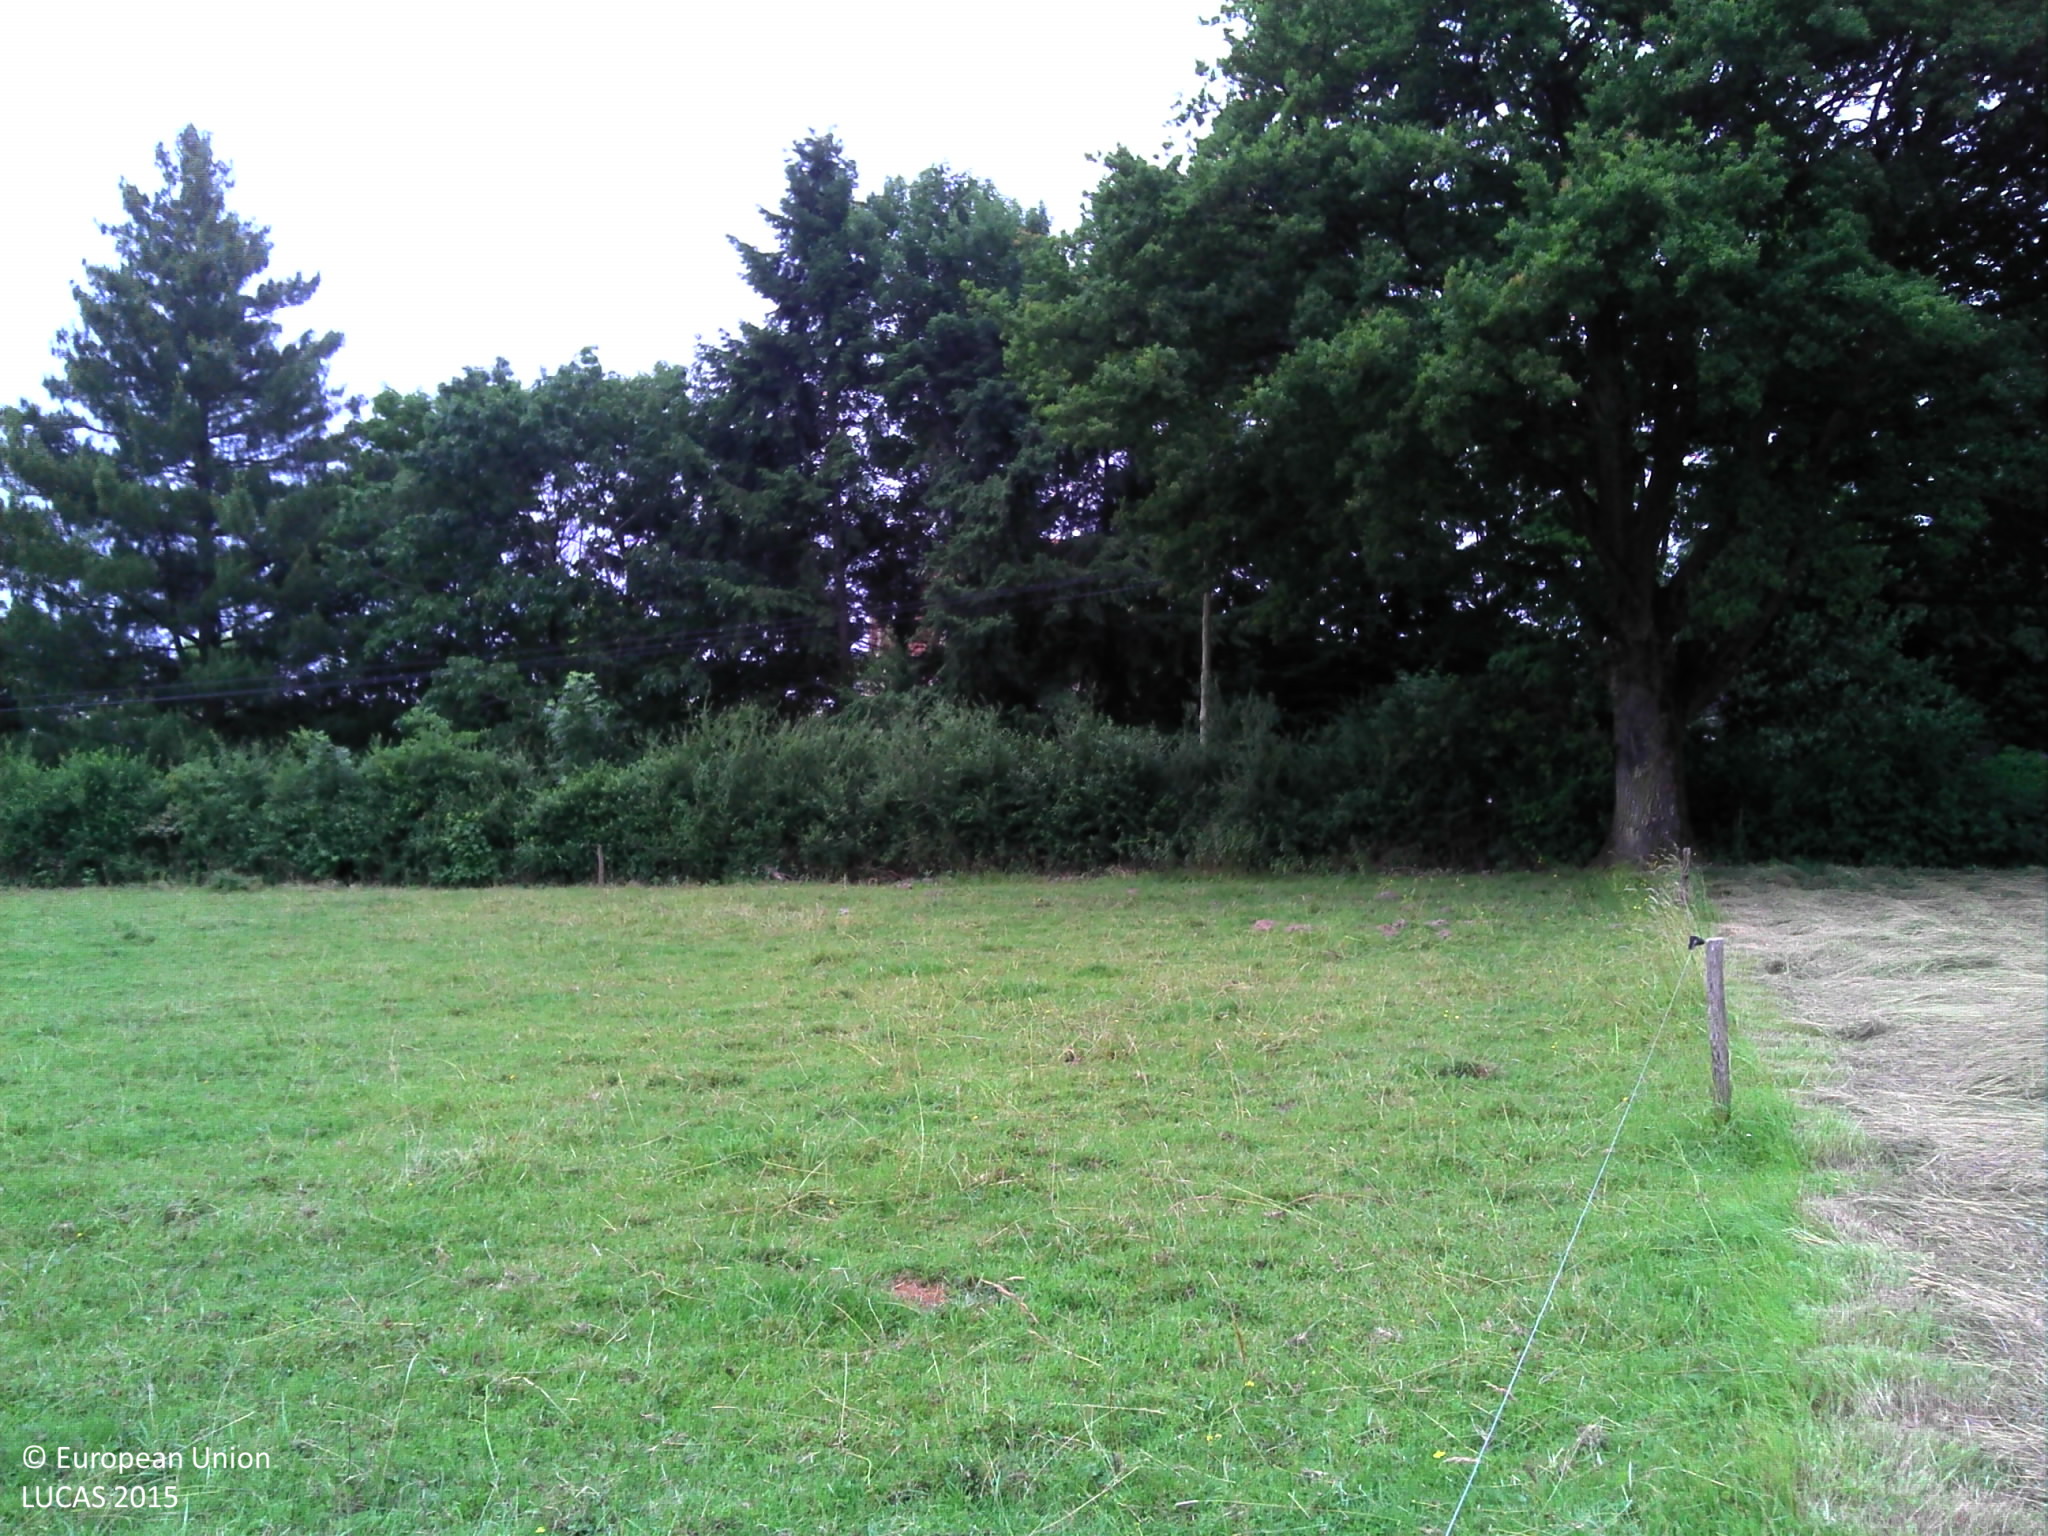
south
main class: Grassland
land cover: Grassland without tree/shrub cover
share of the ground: > 75 %
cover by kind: herbaceous plants 100 %
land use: Agriculture (excluding fallow land and kitchen gardens)
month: June
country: FR
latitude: 46.2880
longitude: 3.0537
